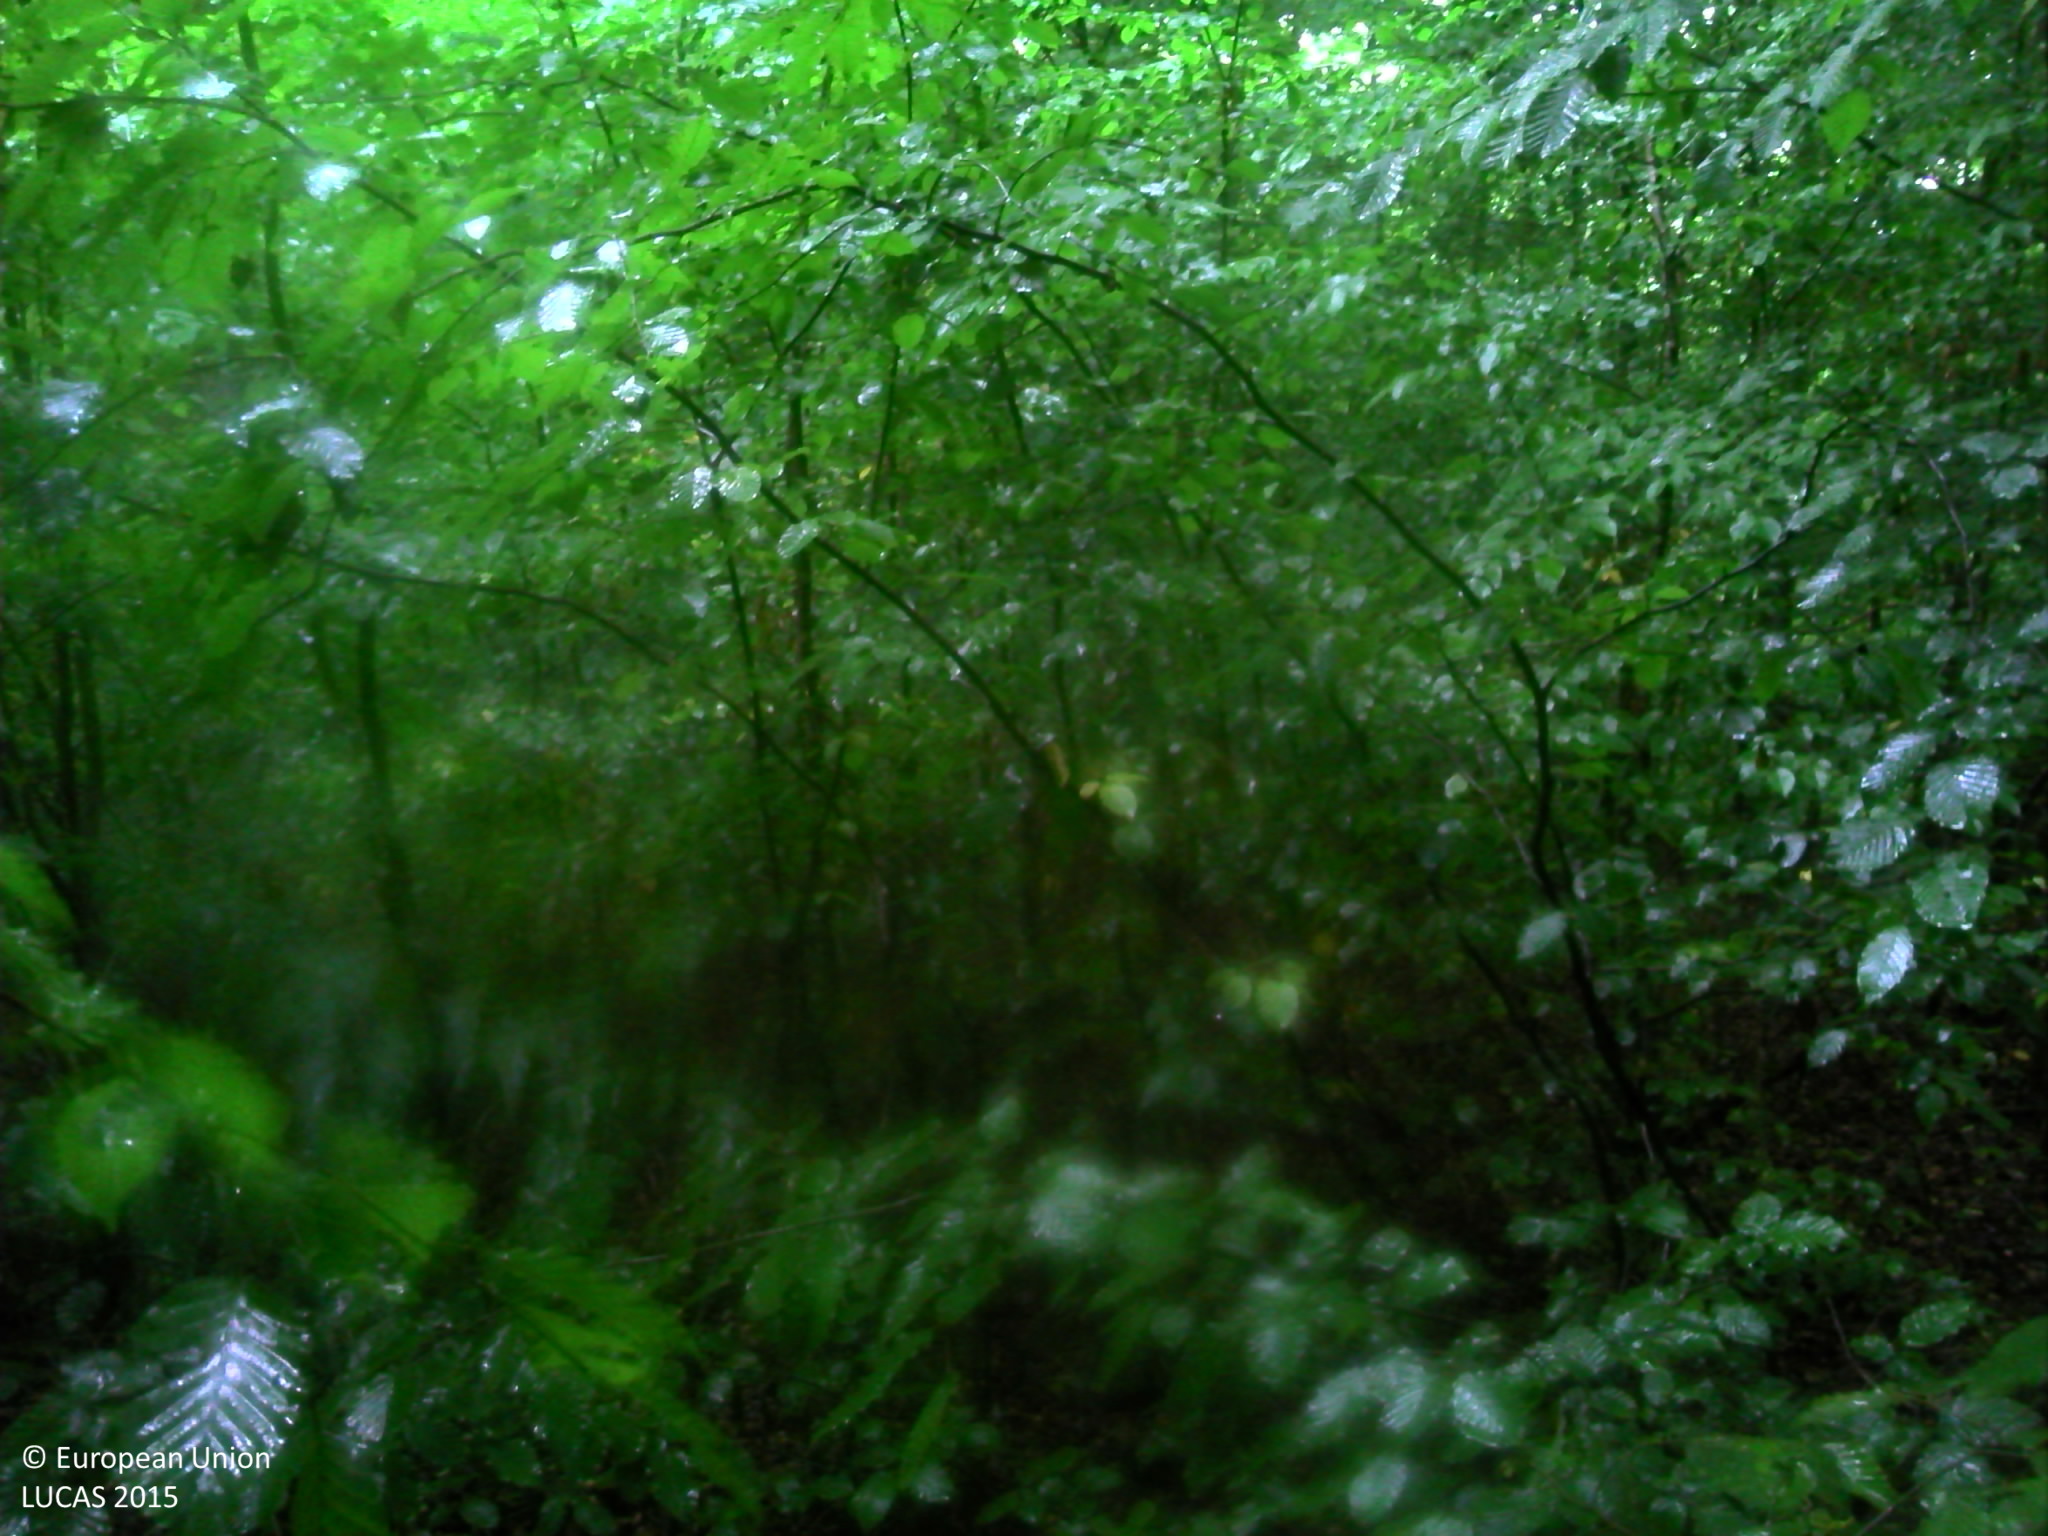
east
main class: Woodland
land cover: Broadleaved woodland
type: mesophytic deciduous forest
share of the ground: > 75 %
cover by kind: broadleaved forest trees 100 %
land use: Forestry
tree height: > 5 m
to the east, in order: Broadleaved woodland; Tracks; Spruce dominated coniferous woodland; Broadleaved woodland; Pine dominated mixed woodland; Pine dominated coniferous woodland; Tracks; Broadleaved woodland
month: July
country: BE
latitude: 50.1302
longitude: 4.6385
